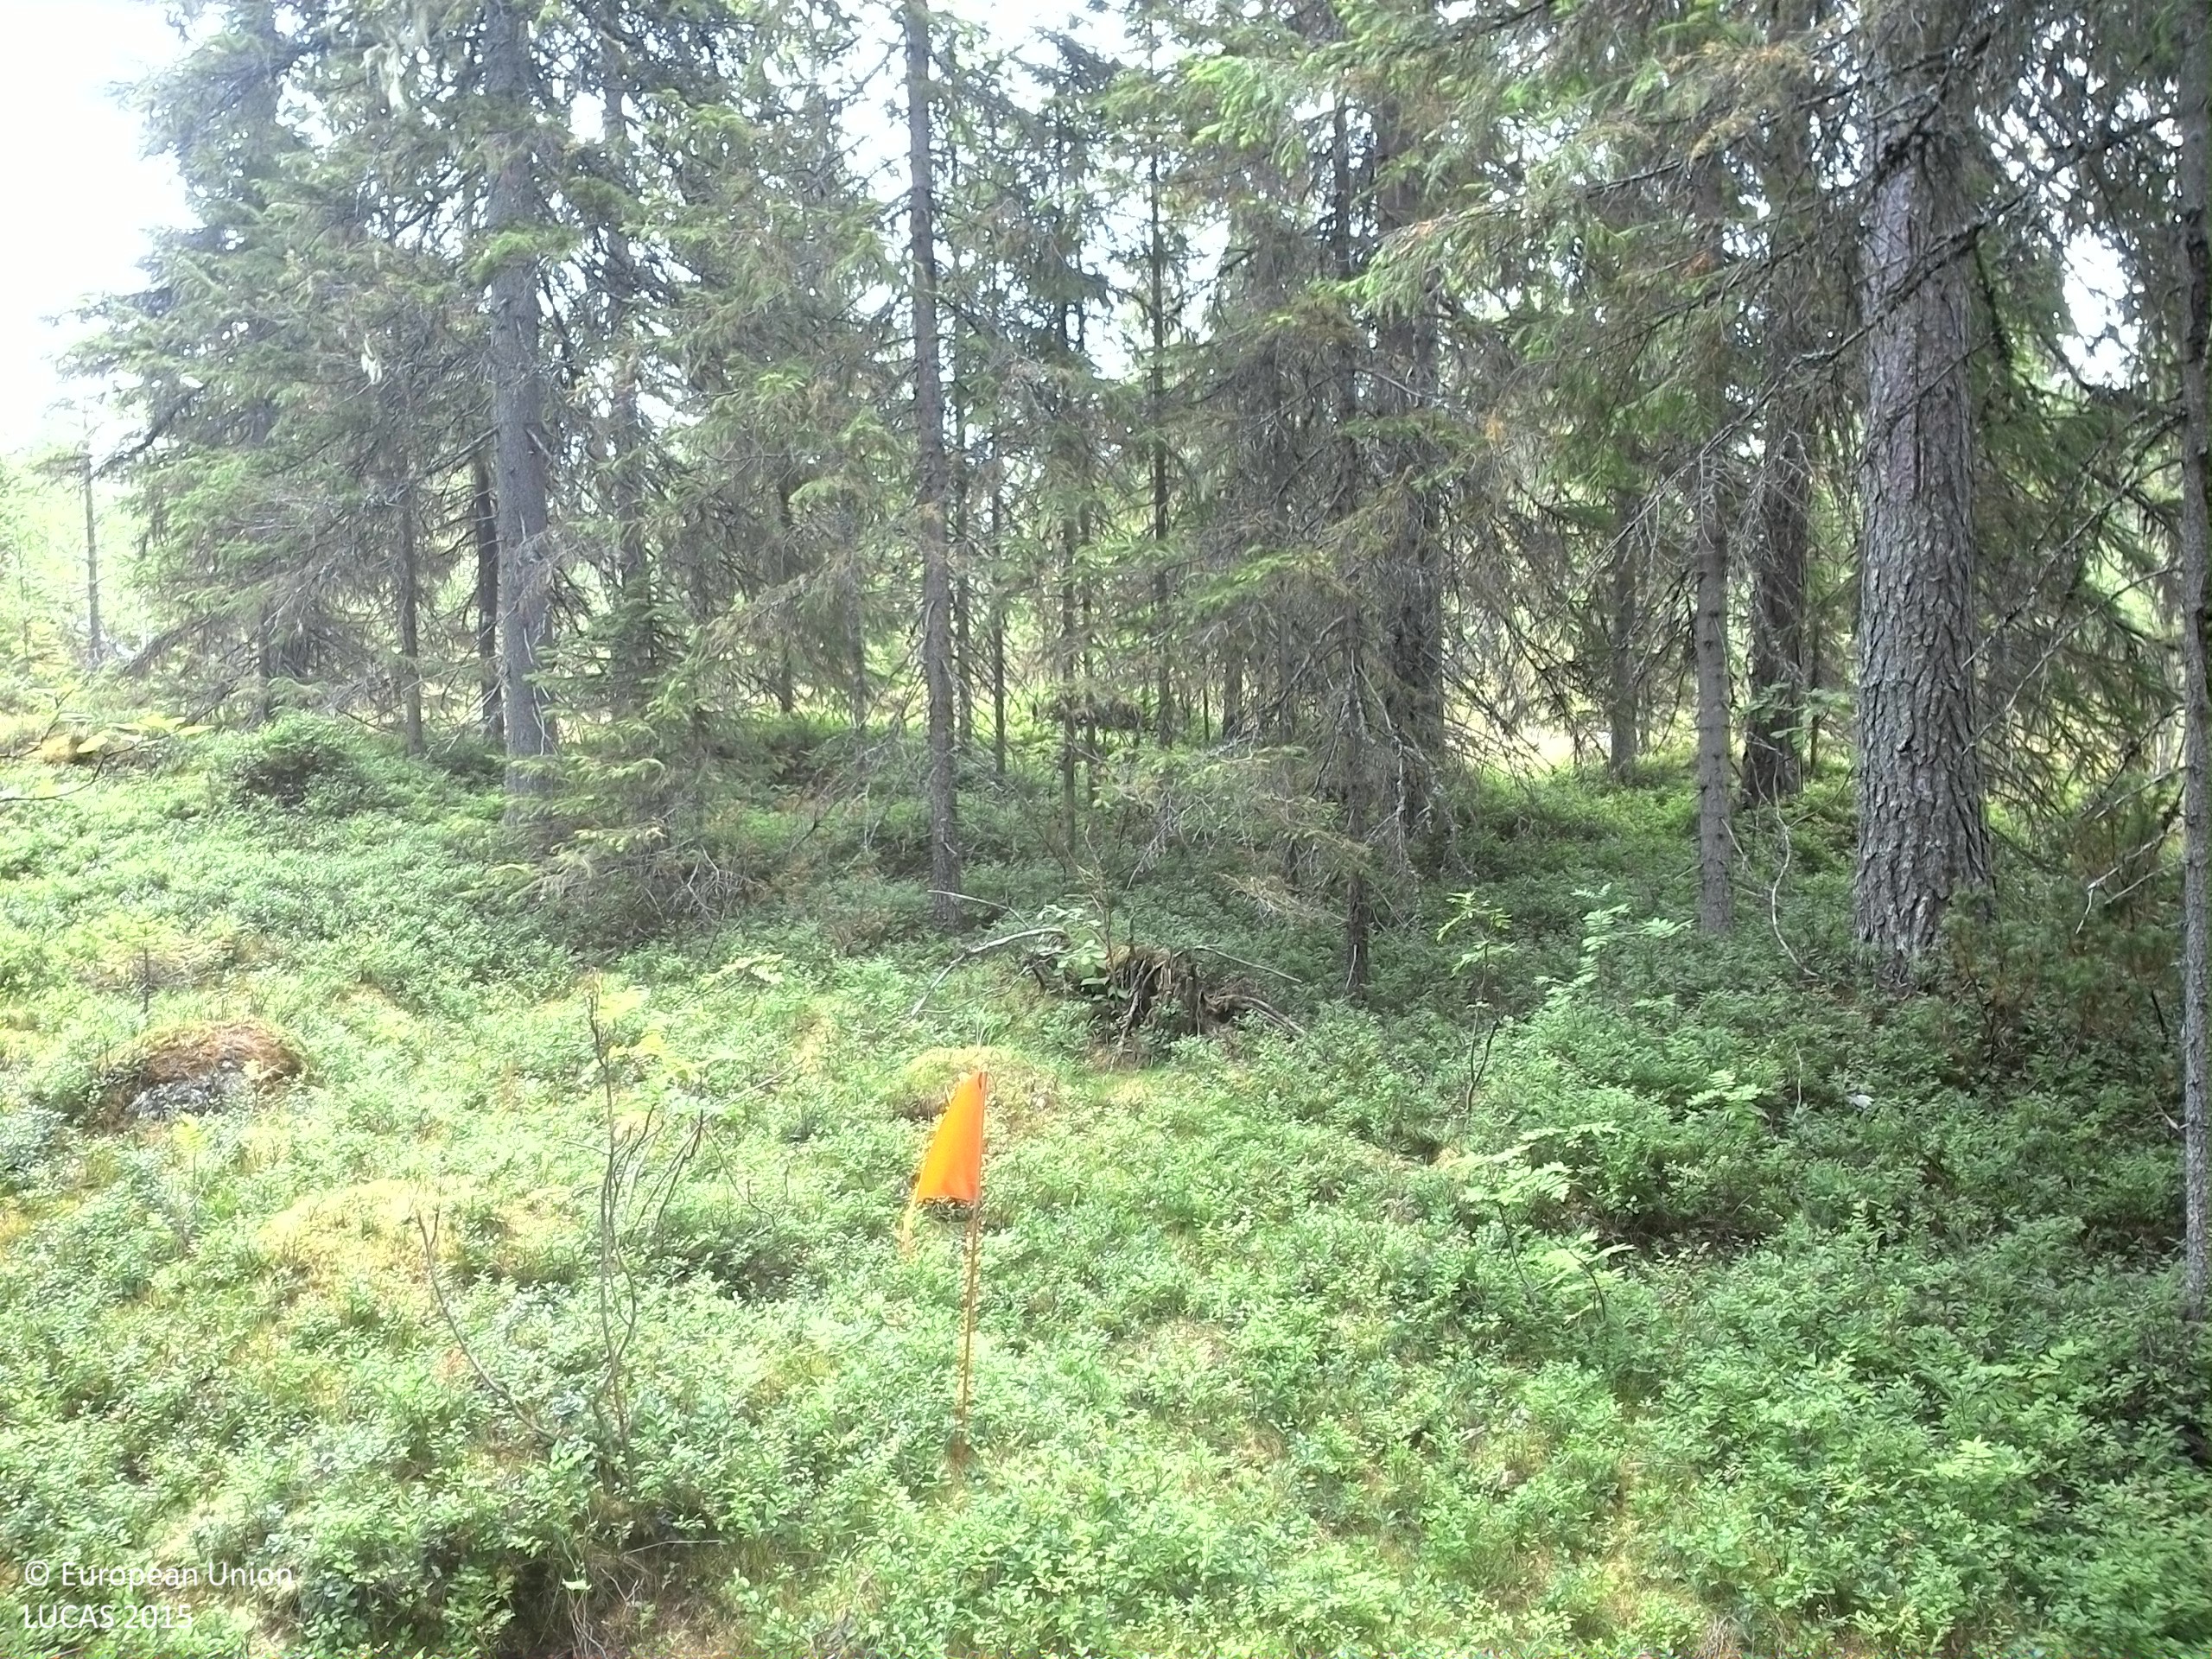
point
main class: Woodland
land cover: Spruce dominated coniferous woodland
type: boreal forest
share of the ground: > 75 %
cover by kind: coniferous forest trees 75 %, shrubs 20 %, lichens and mosses 5 %
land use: Forestry
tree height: > 5 m
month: August
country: SE
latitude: 63.7929
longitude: 17.3393
